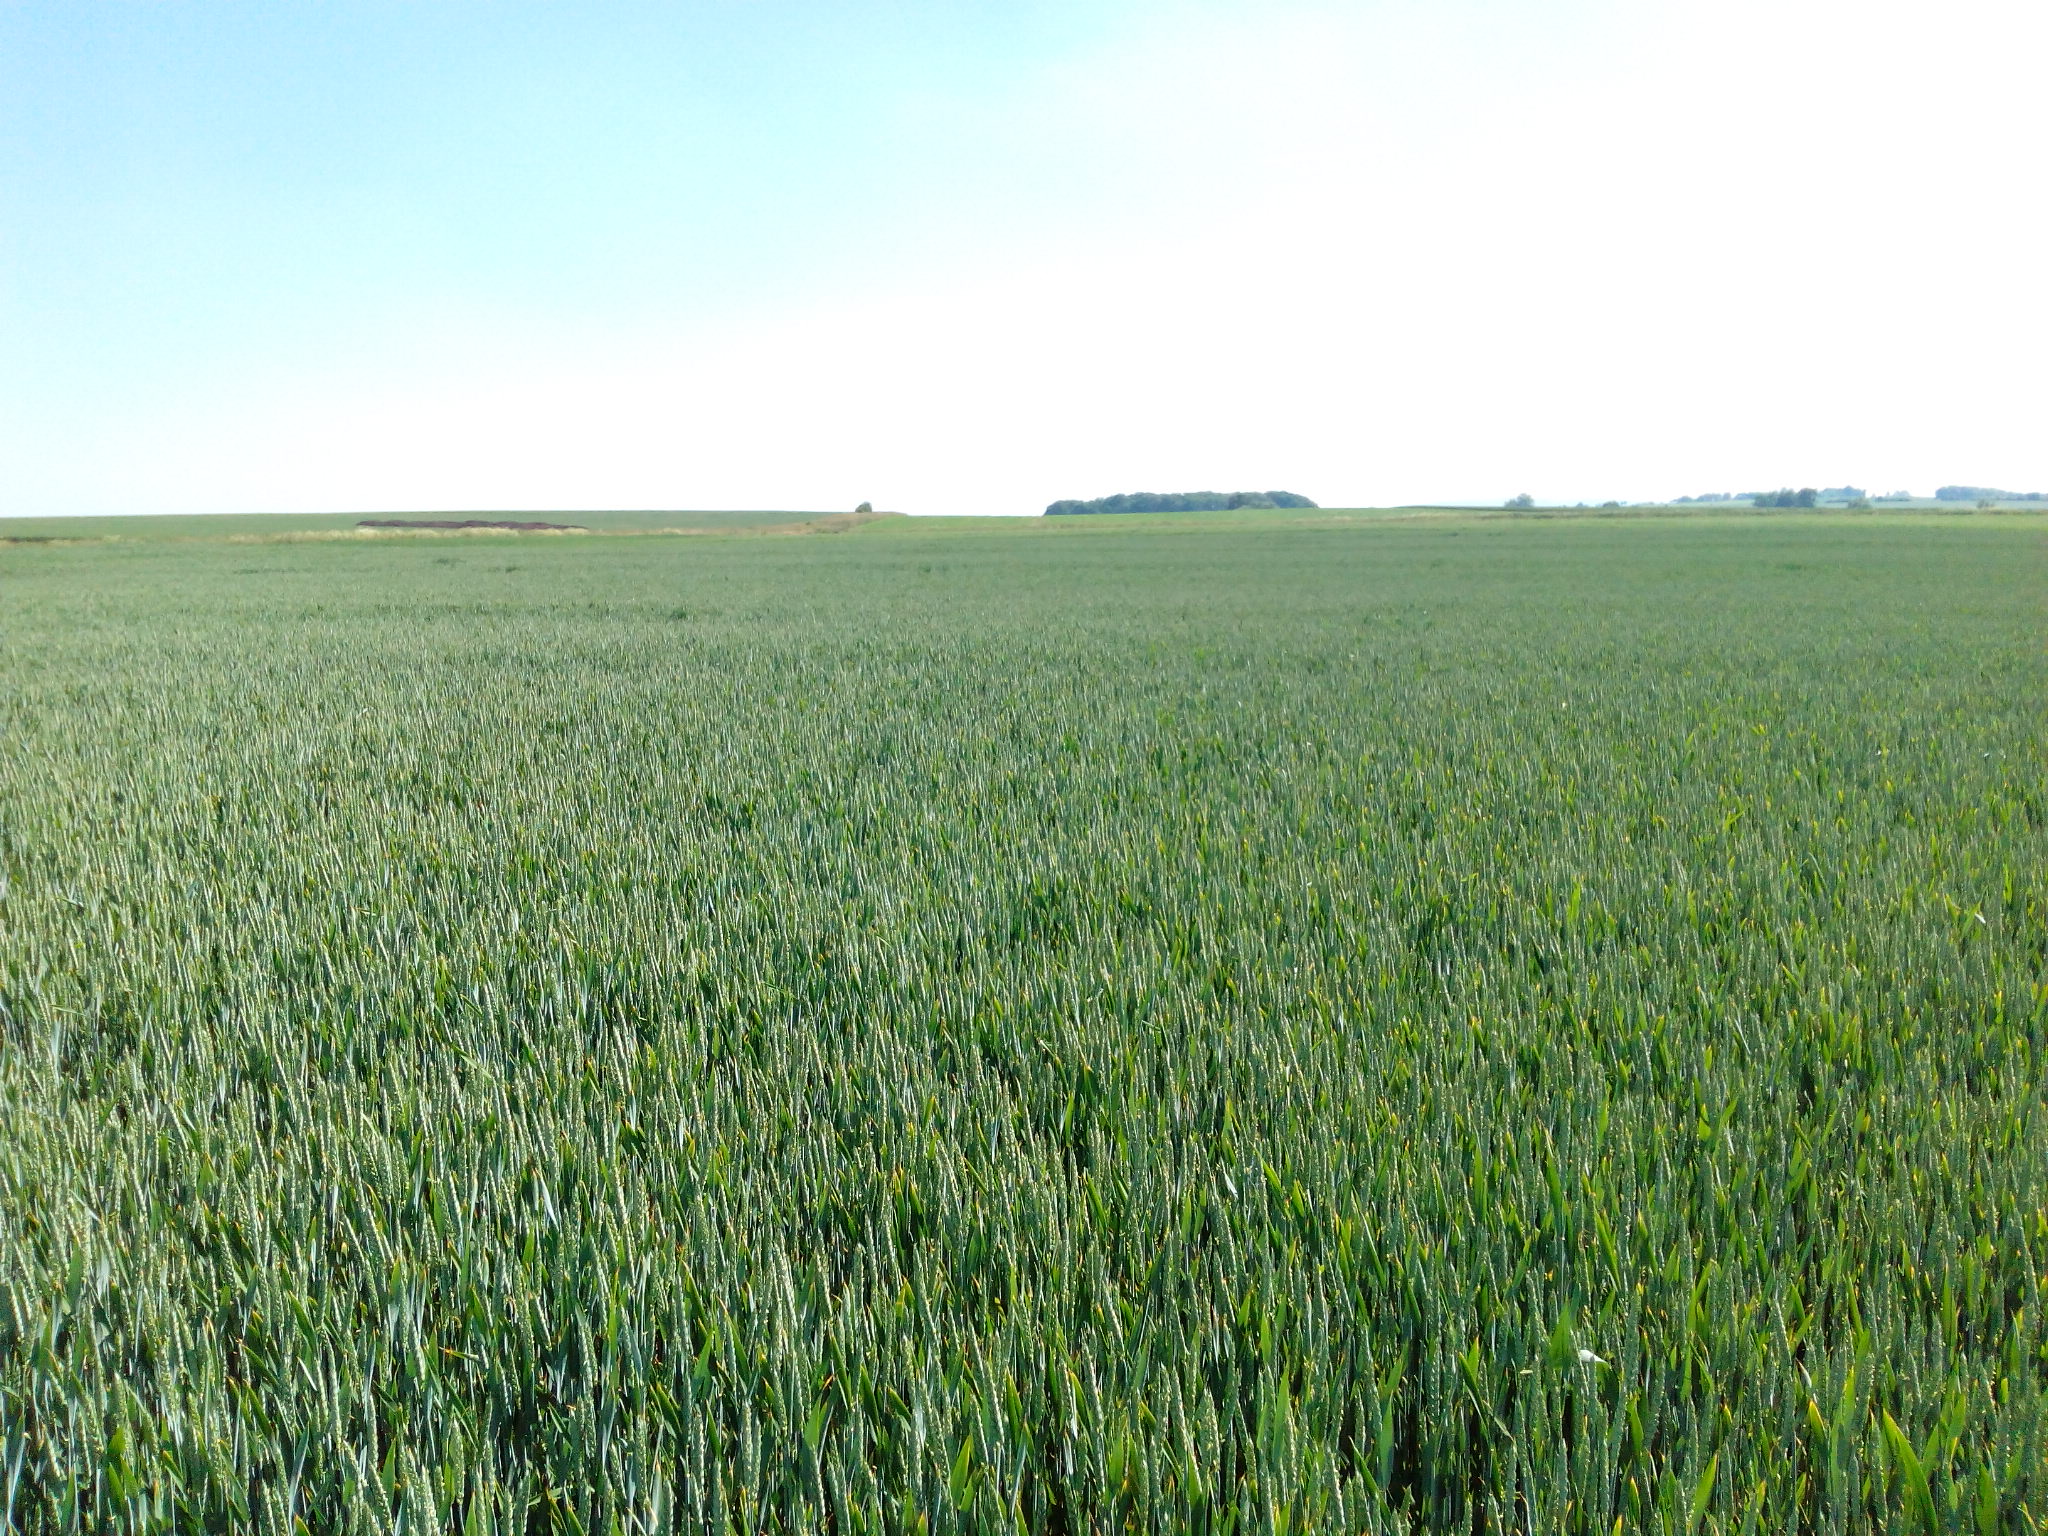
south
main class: Cropland
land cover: Common wheat
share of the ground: > 75 %
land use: Agriculture (excluding fallow land and kitchen gardens)
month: June
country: DE
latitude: 52.2696
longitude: 9.8975
